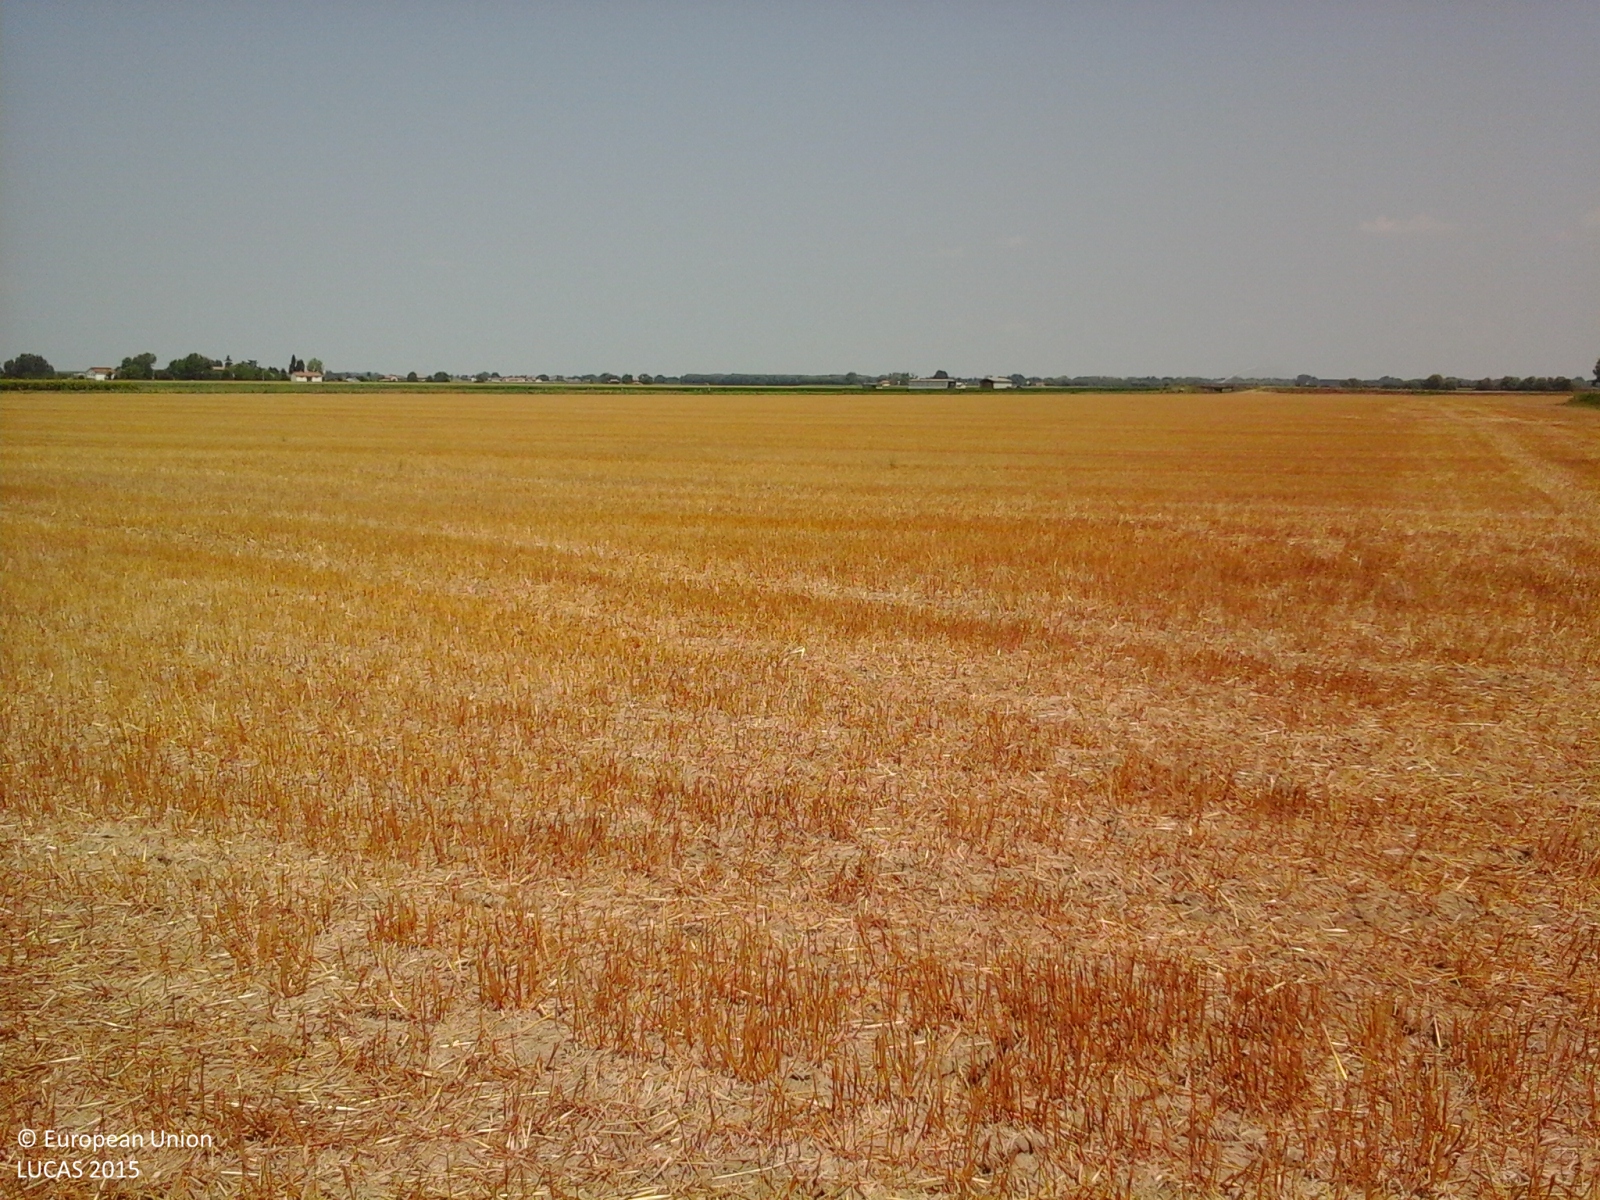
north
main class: Cropland
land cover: Barley
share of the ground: > 75 %
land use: Agriculture (excluding fallow land and kitchen gardens)
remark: Harvested field
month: July
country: IT
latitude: 44.6449
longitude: 11.5979
